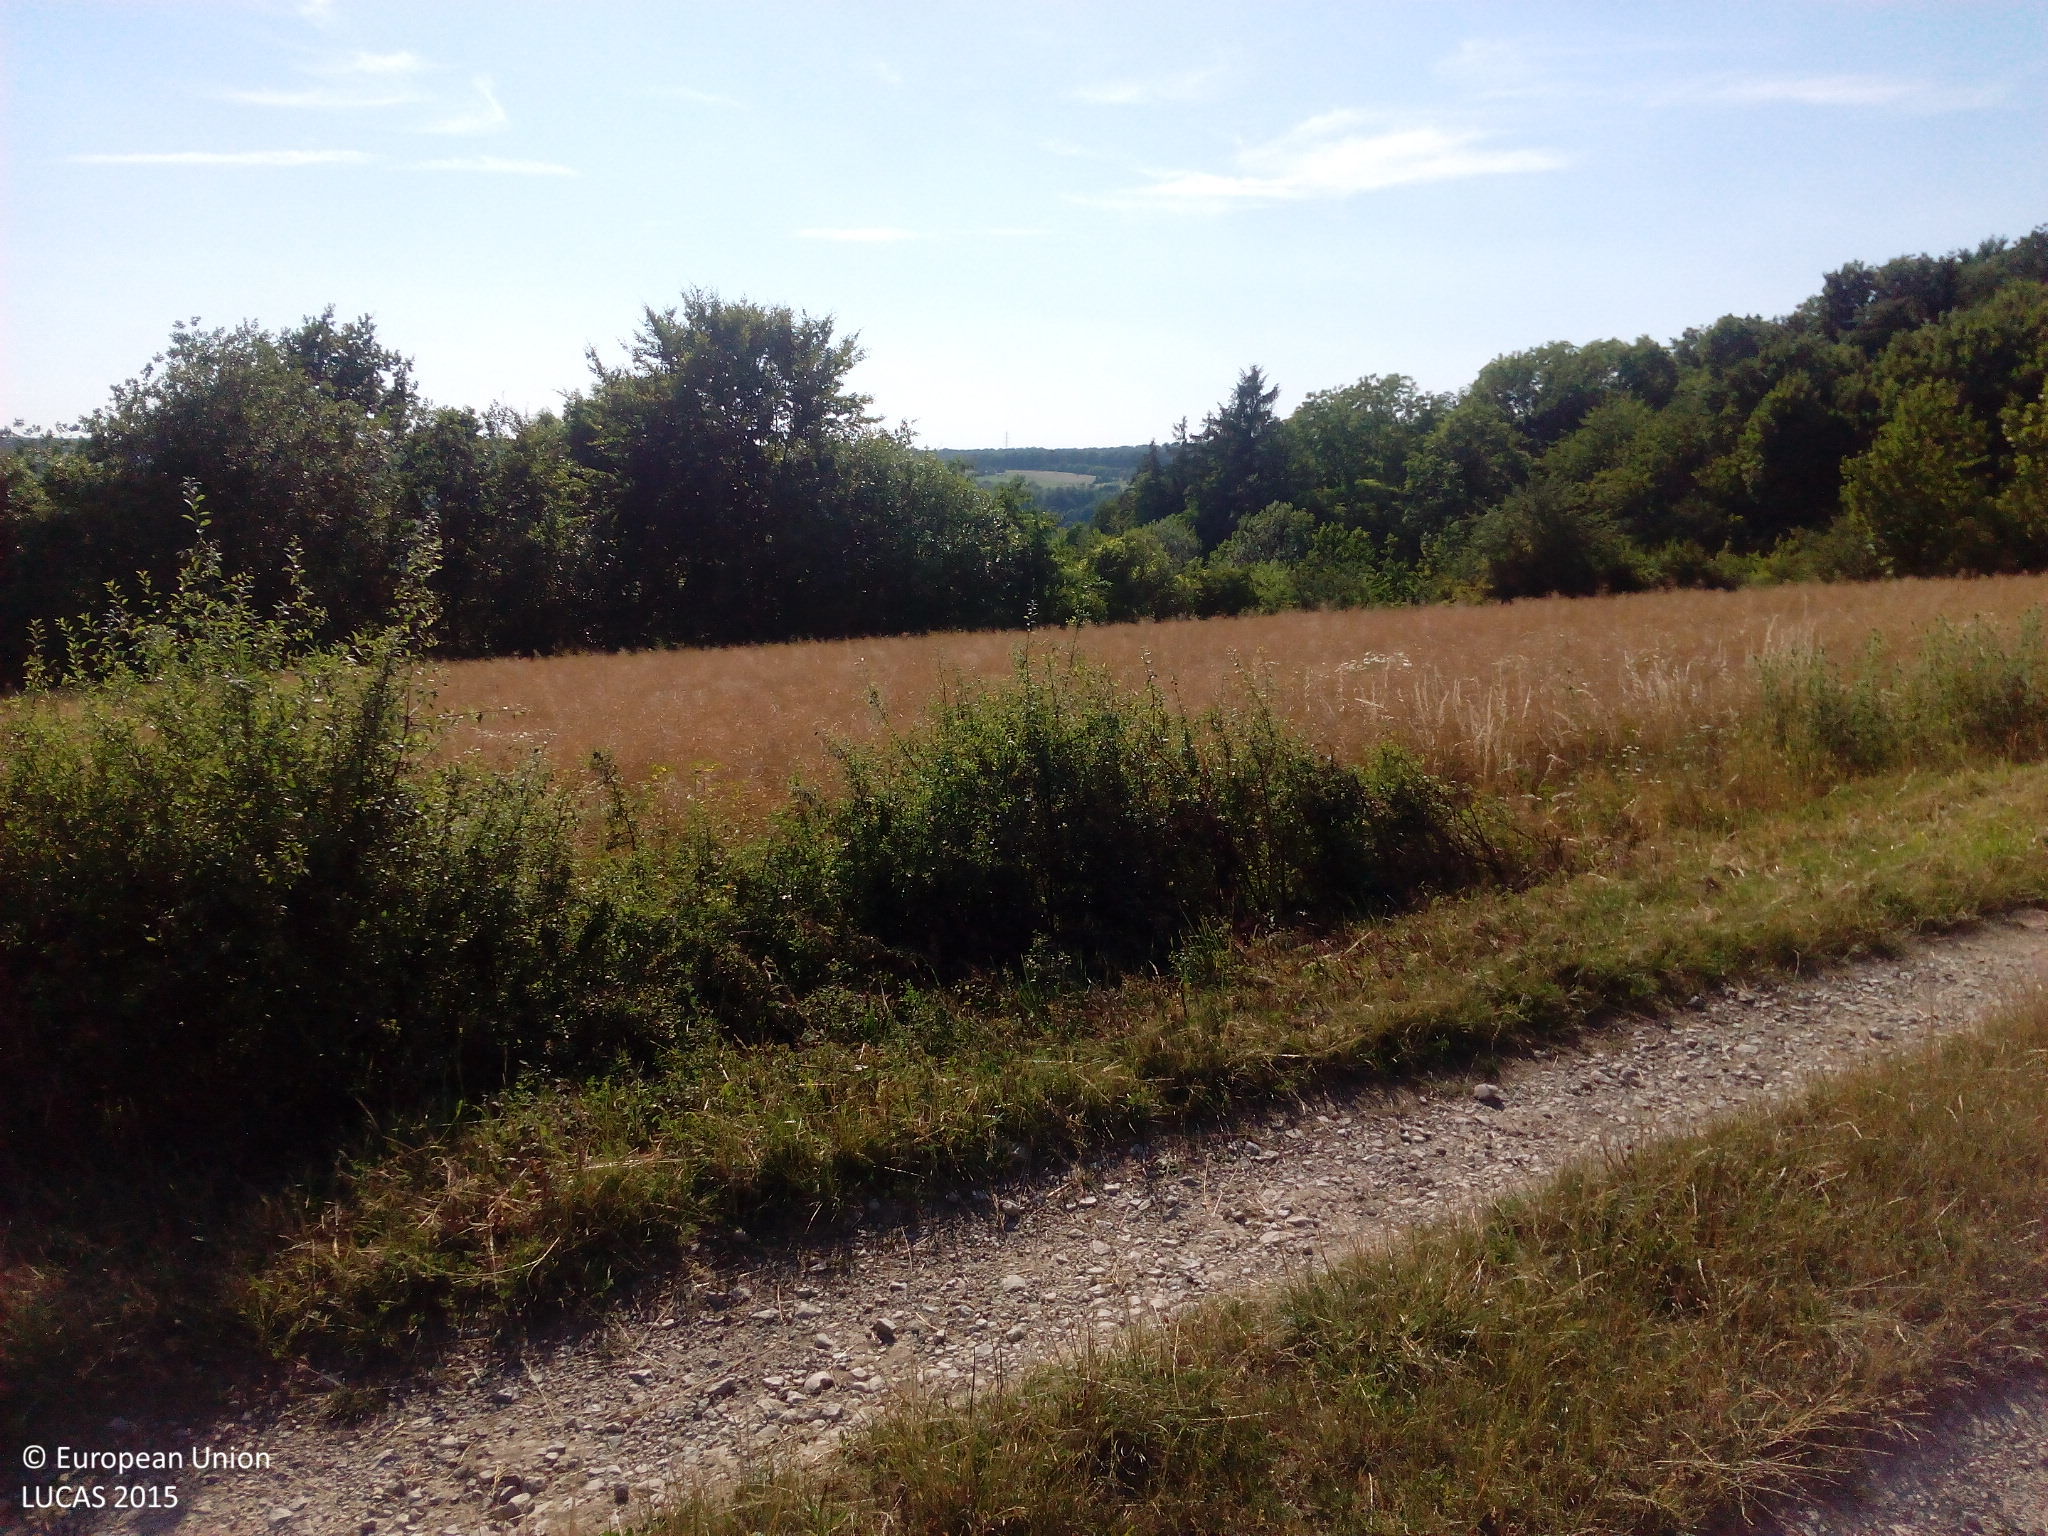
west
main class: Cropland
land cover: Rape and turnip rape
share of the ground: > 75 %
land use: Agriculture (excluding fallow land and kitchen gardens)
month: July
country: DE
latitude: 49.1785
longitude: 7.2157
